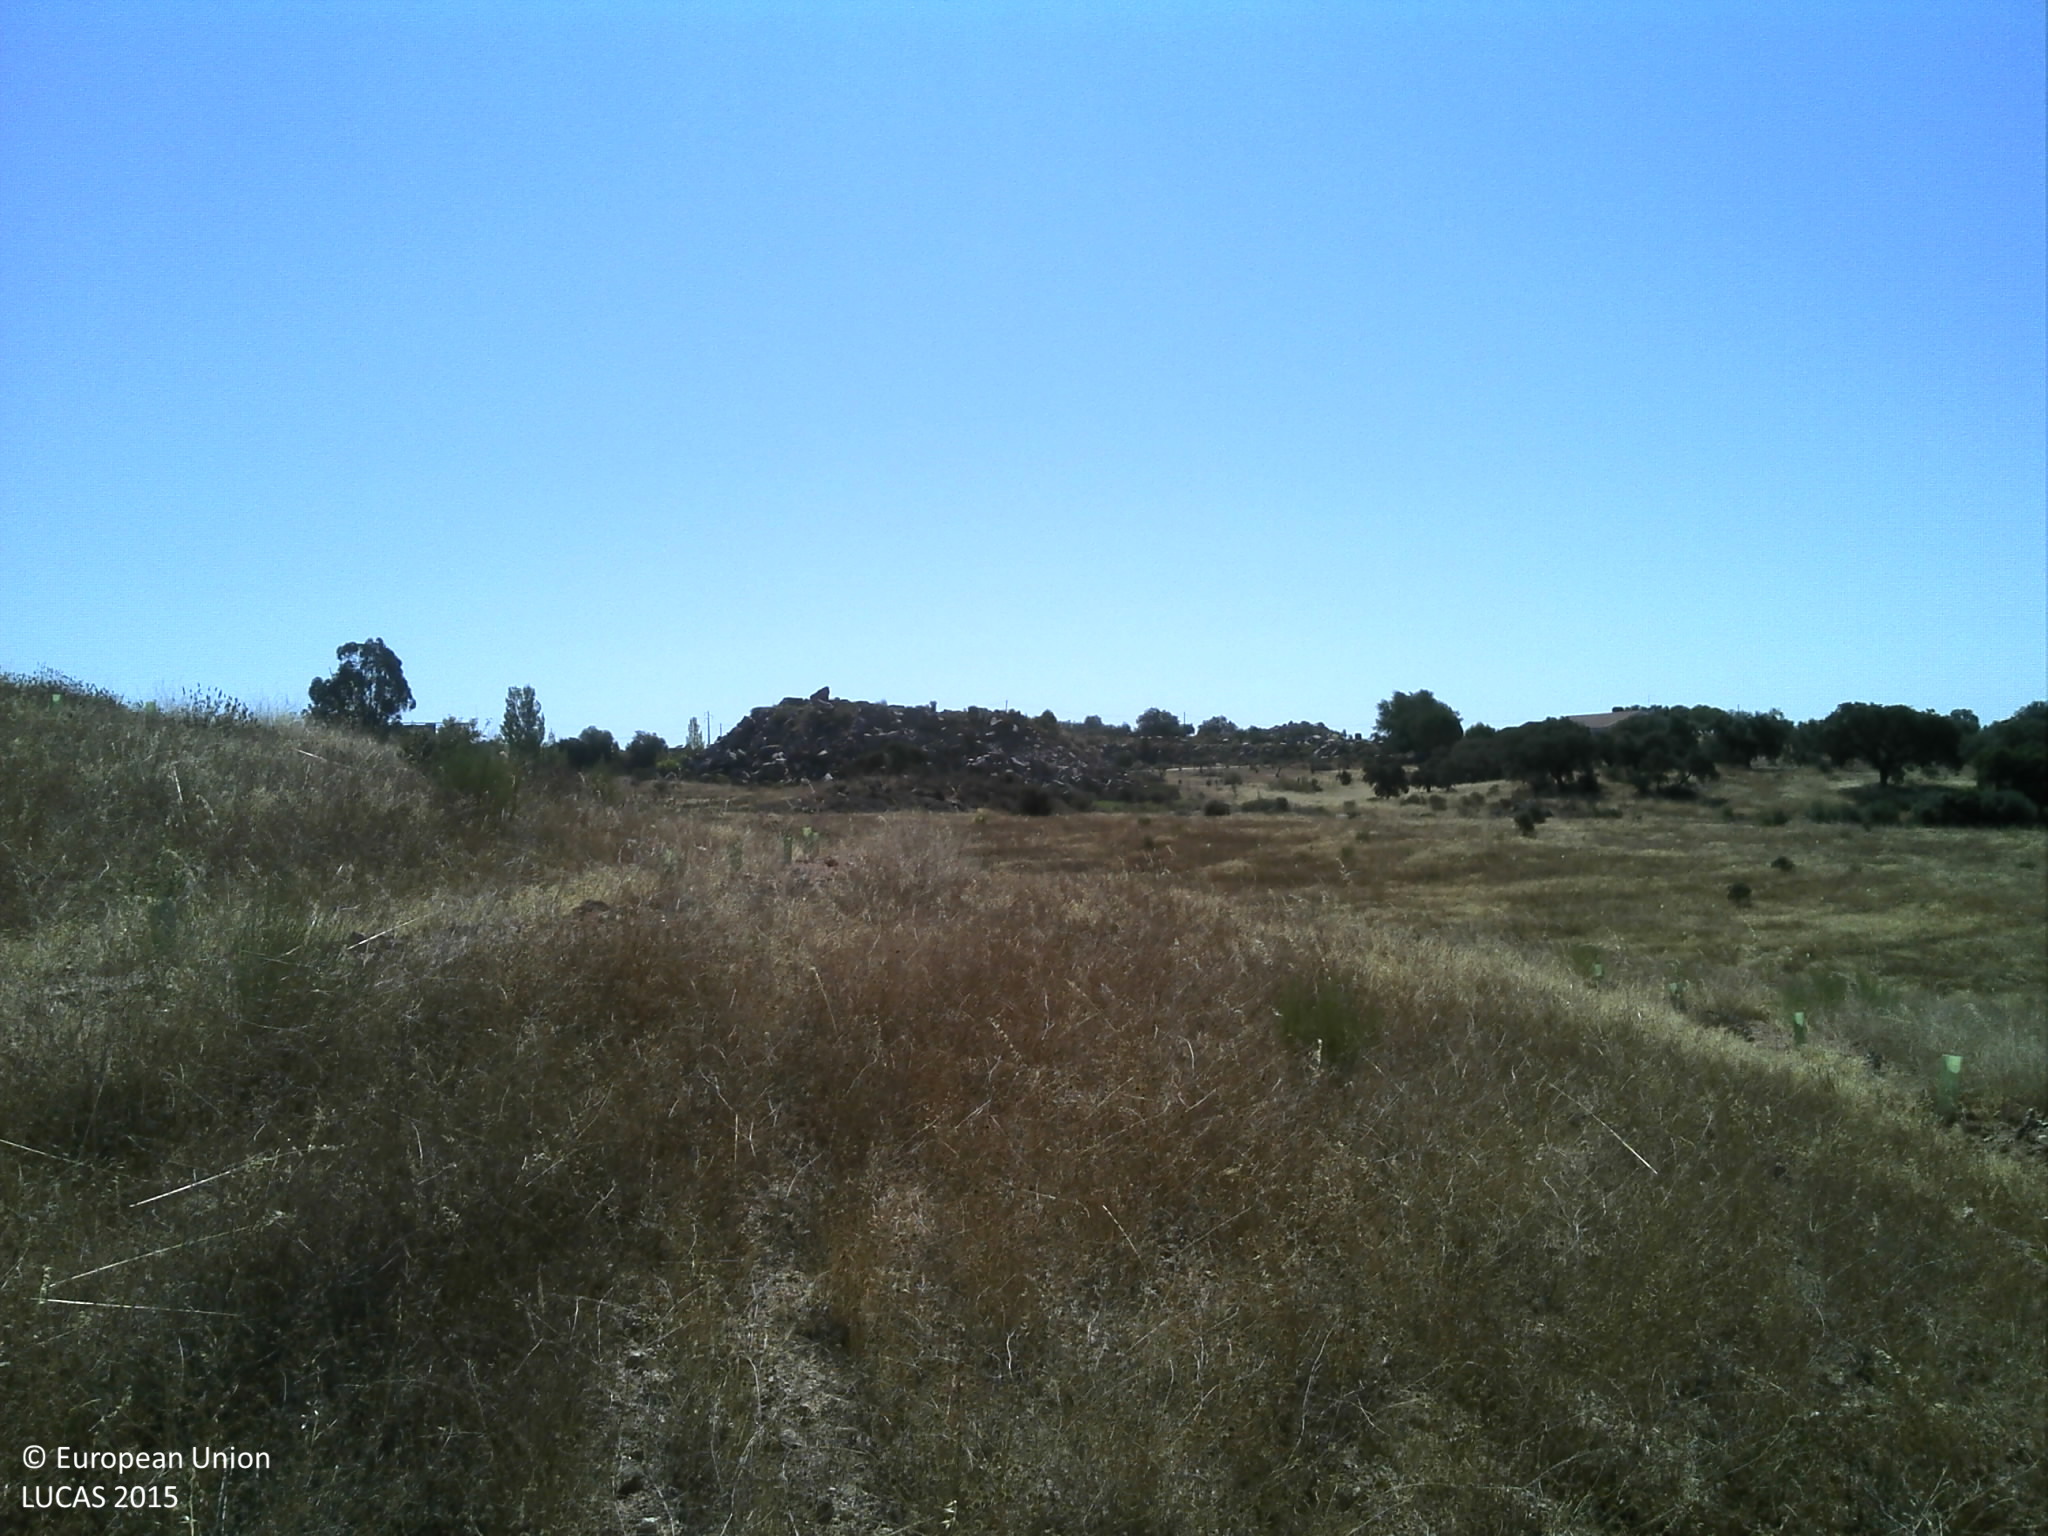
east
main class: Grassland
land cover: Grassland with sparse tree/shrub cover
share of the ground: 25 - 50 %
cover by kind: herbaceous plants 50 %, unconsolidated bare surface 45 %, broadleaved forest trees 5 %
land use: Forestry
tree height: < 5 m
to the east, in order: Grassland with sparse tree/shrub cover; Fences; Grassland with sparse tree/shrub cover
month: July
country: PT
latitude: 39.0802
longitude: -7.4352
